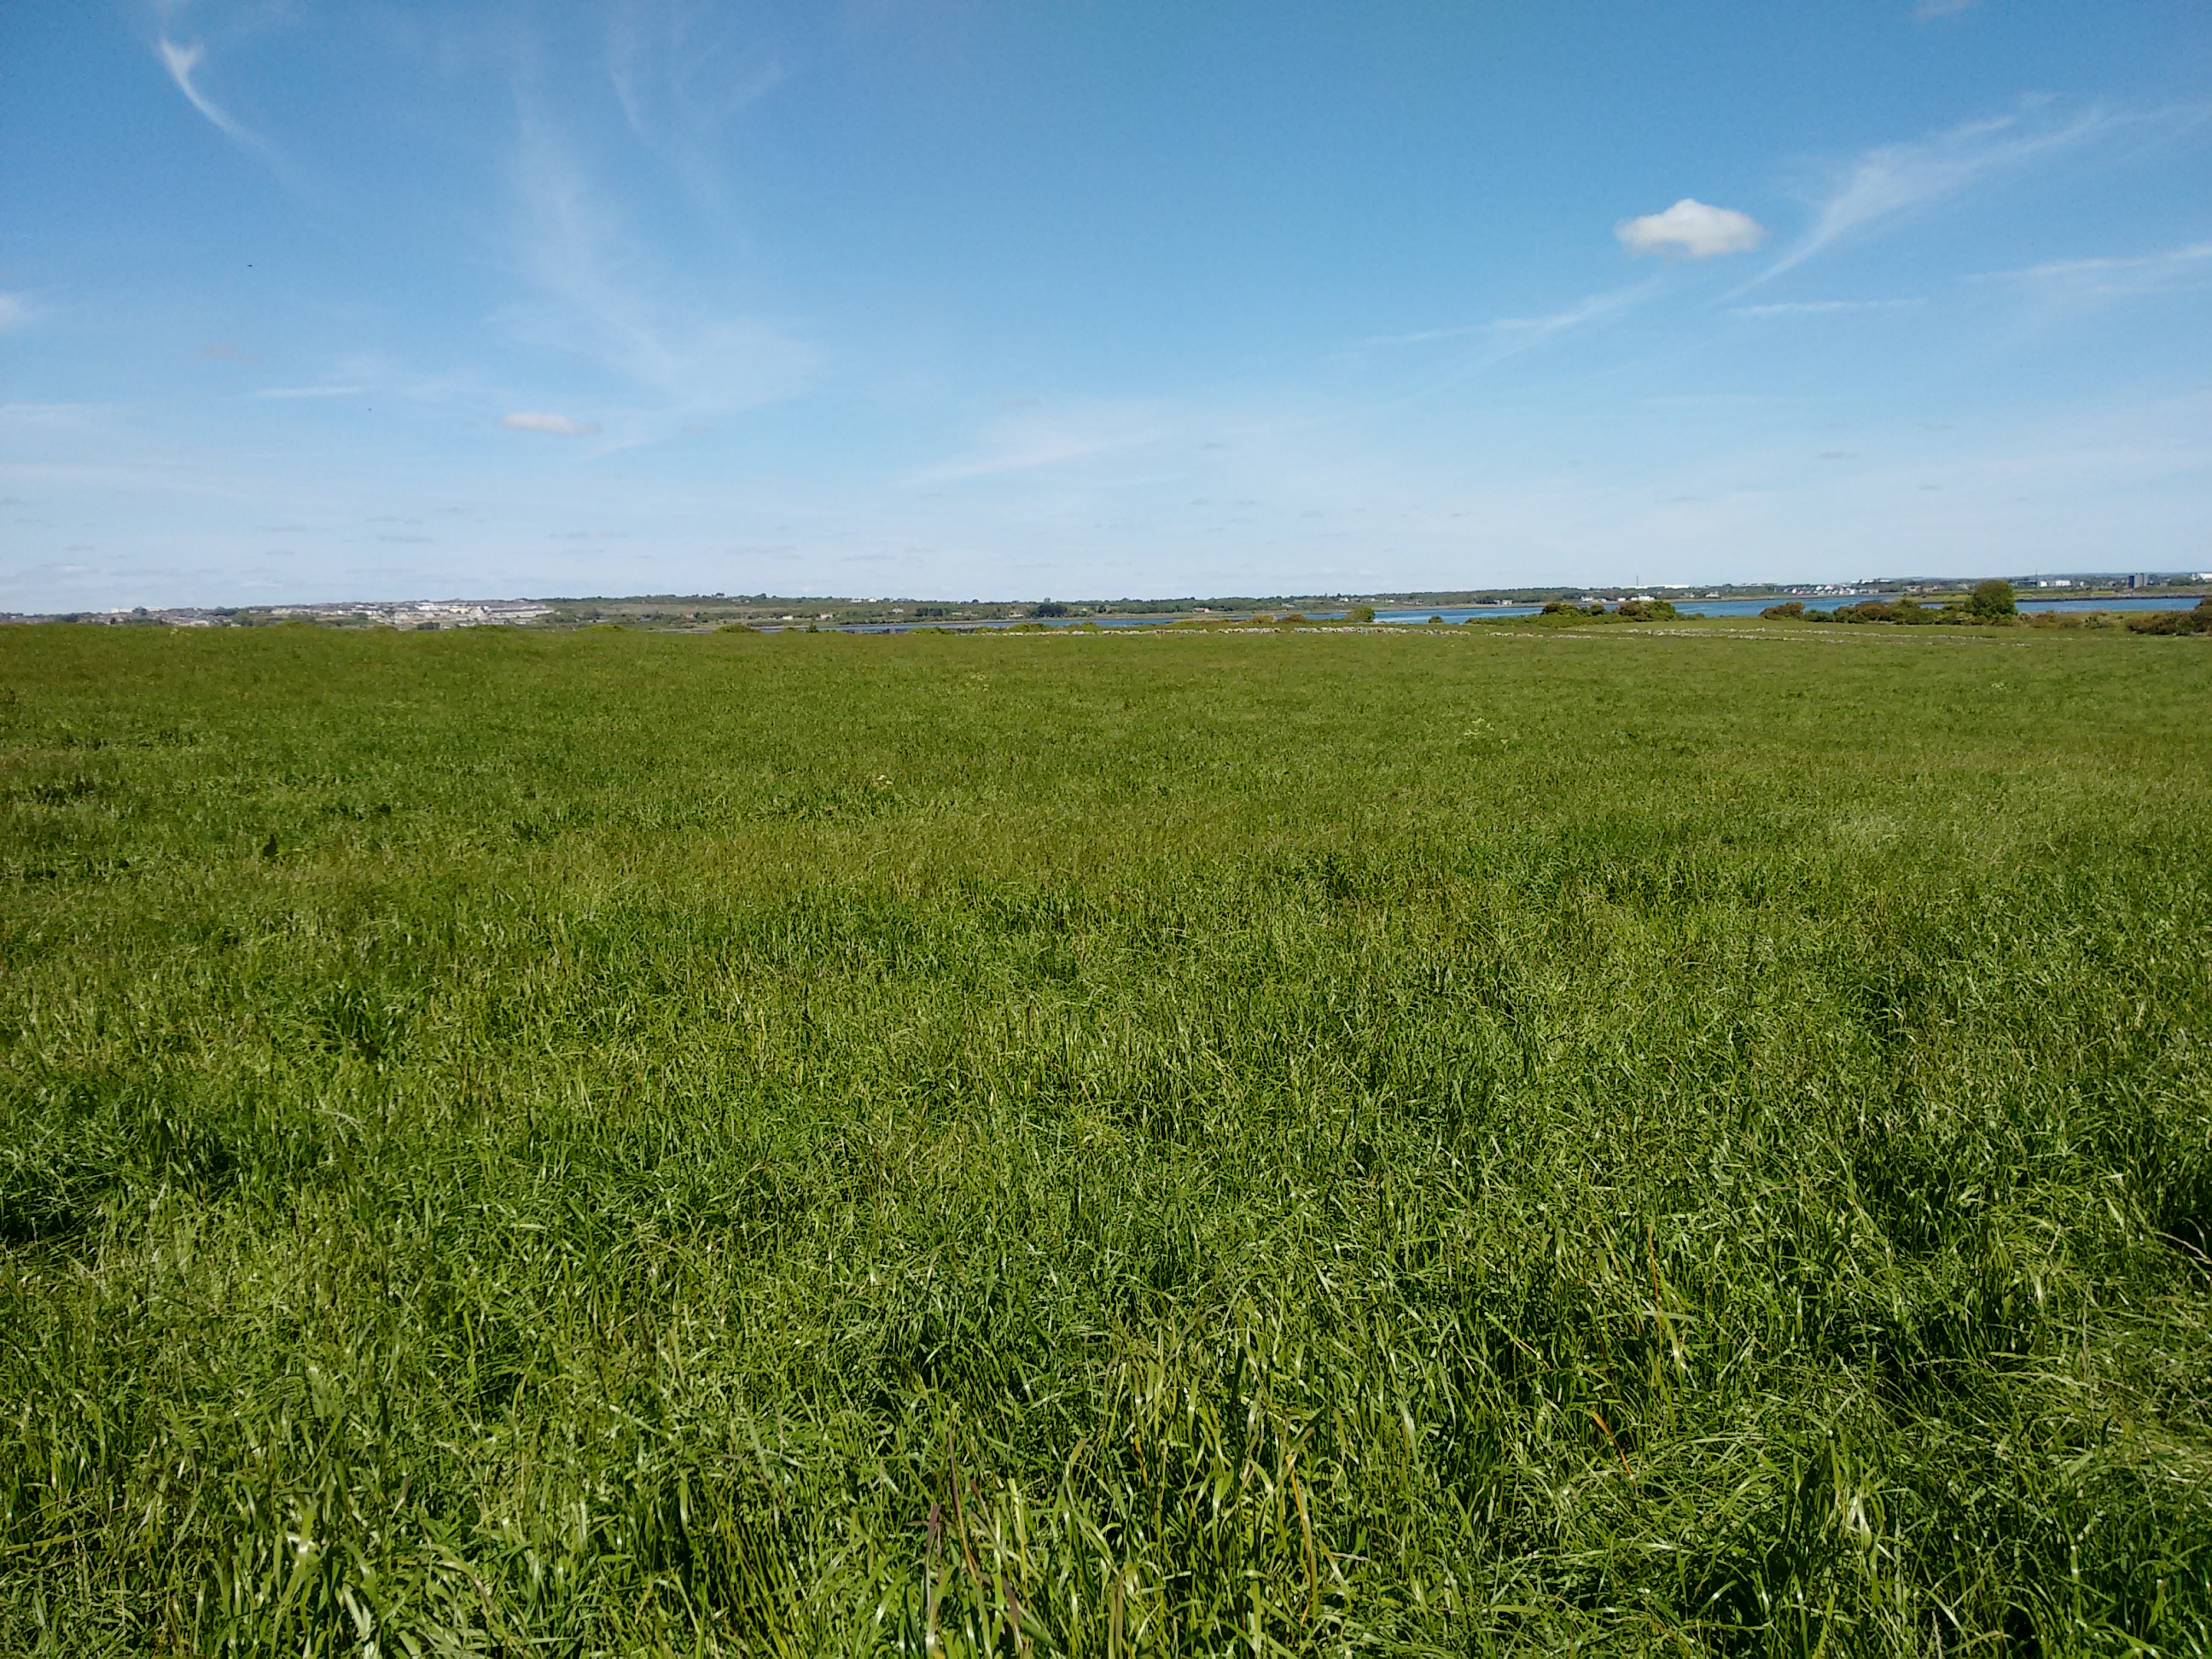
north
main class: Grassland
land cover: Grassland without tree/shrub cover
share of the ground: > 75 %
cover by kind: herbaceous plants 100 %
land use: Agriculture (excluding fallow land and kitchen gardens)
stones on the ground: < 10 %
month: June
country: IE
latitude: 53.2523
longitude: -8.9613
